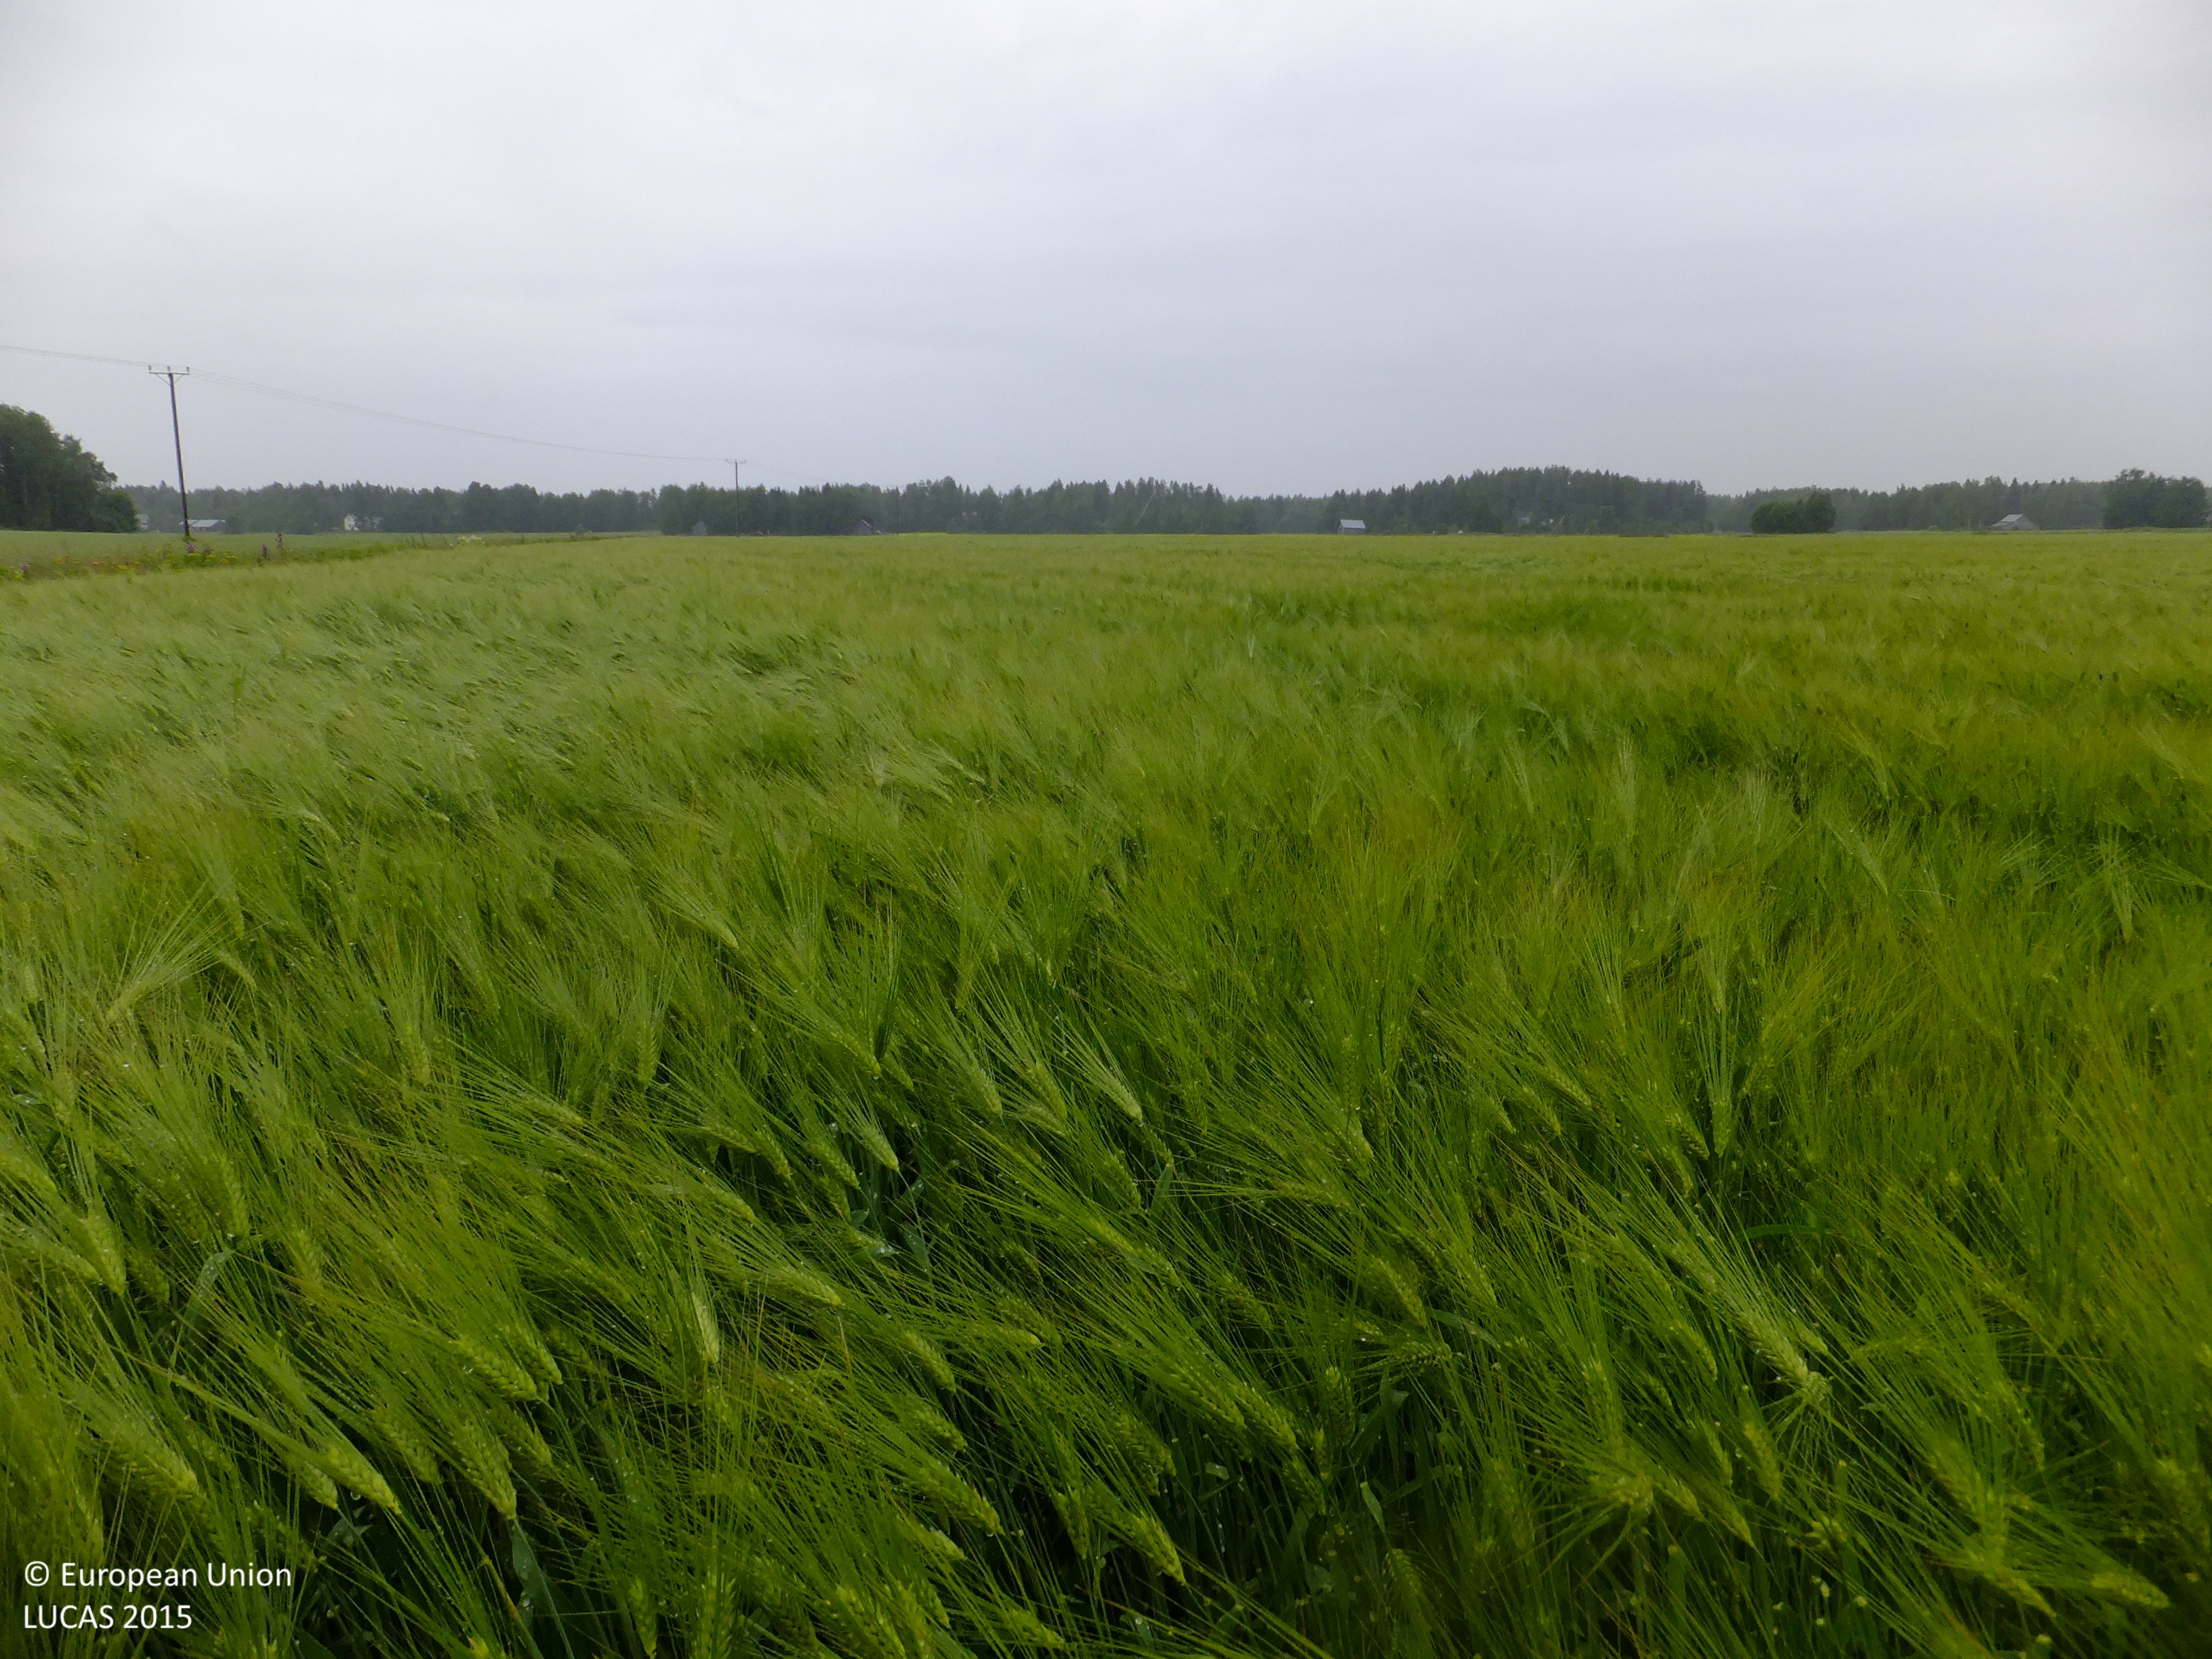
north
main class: Cropland
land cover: Barley
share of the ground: > 75 %
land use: Agriculture (excluding fallow land and kitchen gardens)
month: July
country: FI
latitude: 63.1833
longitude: 21.8637
